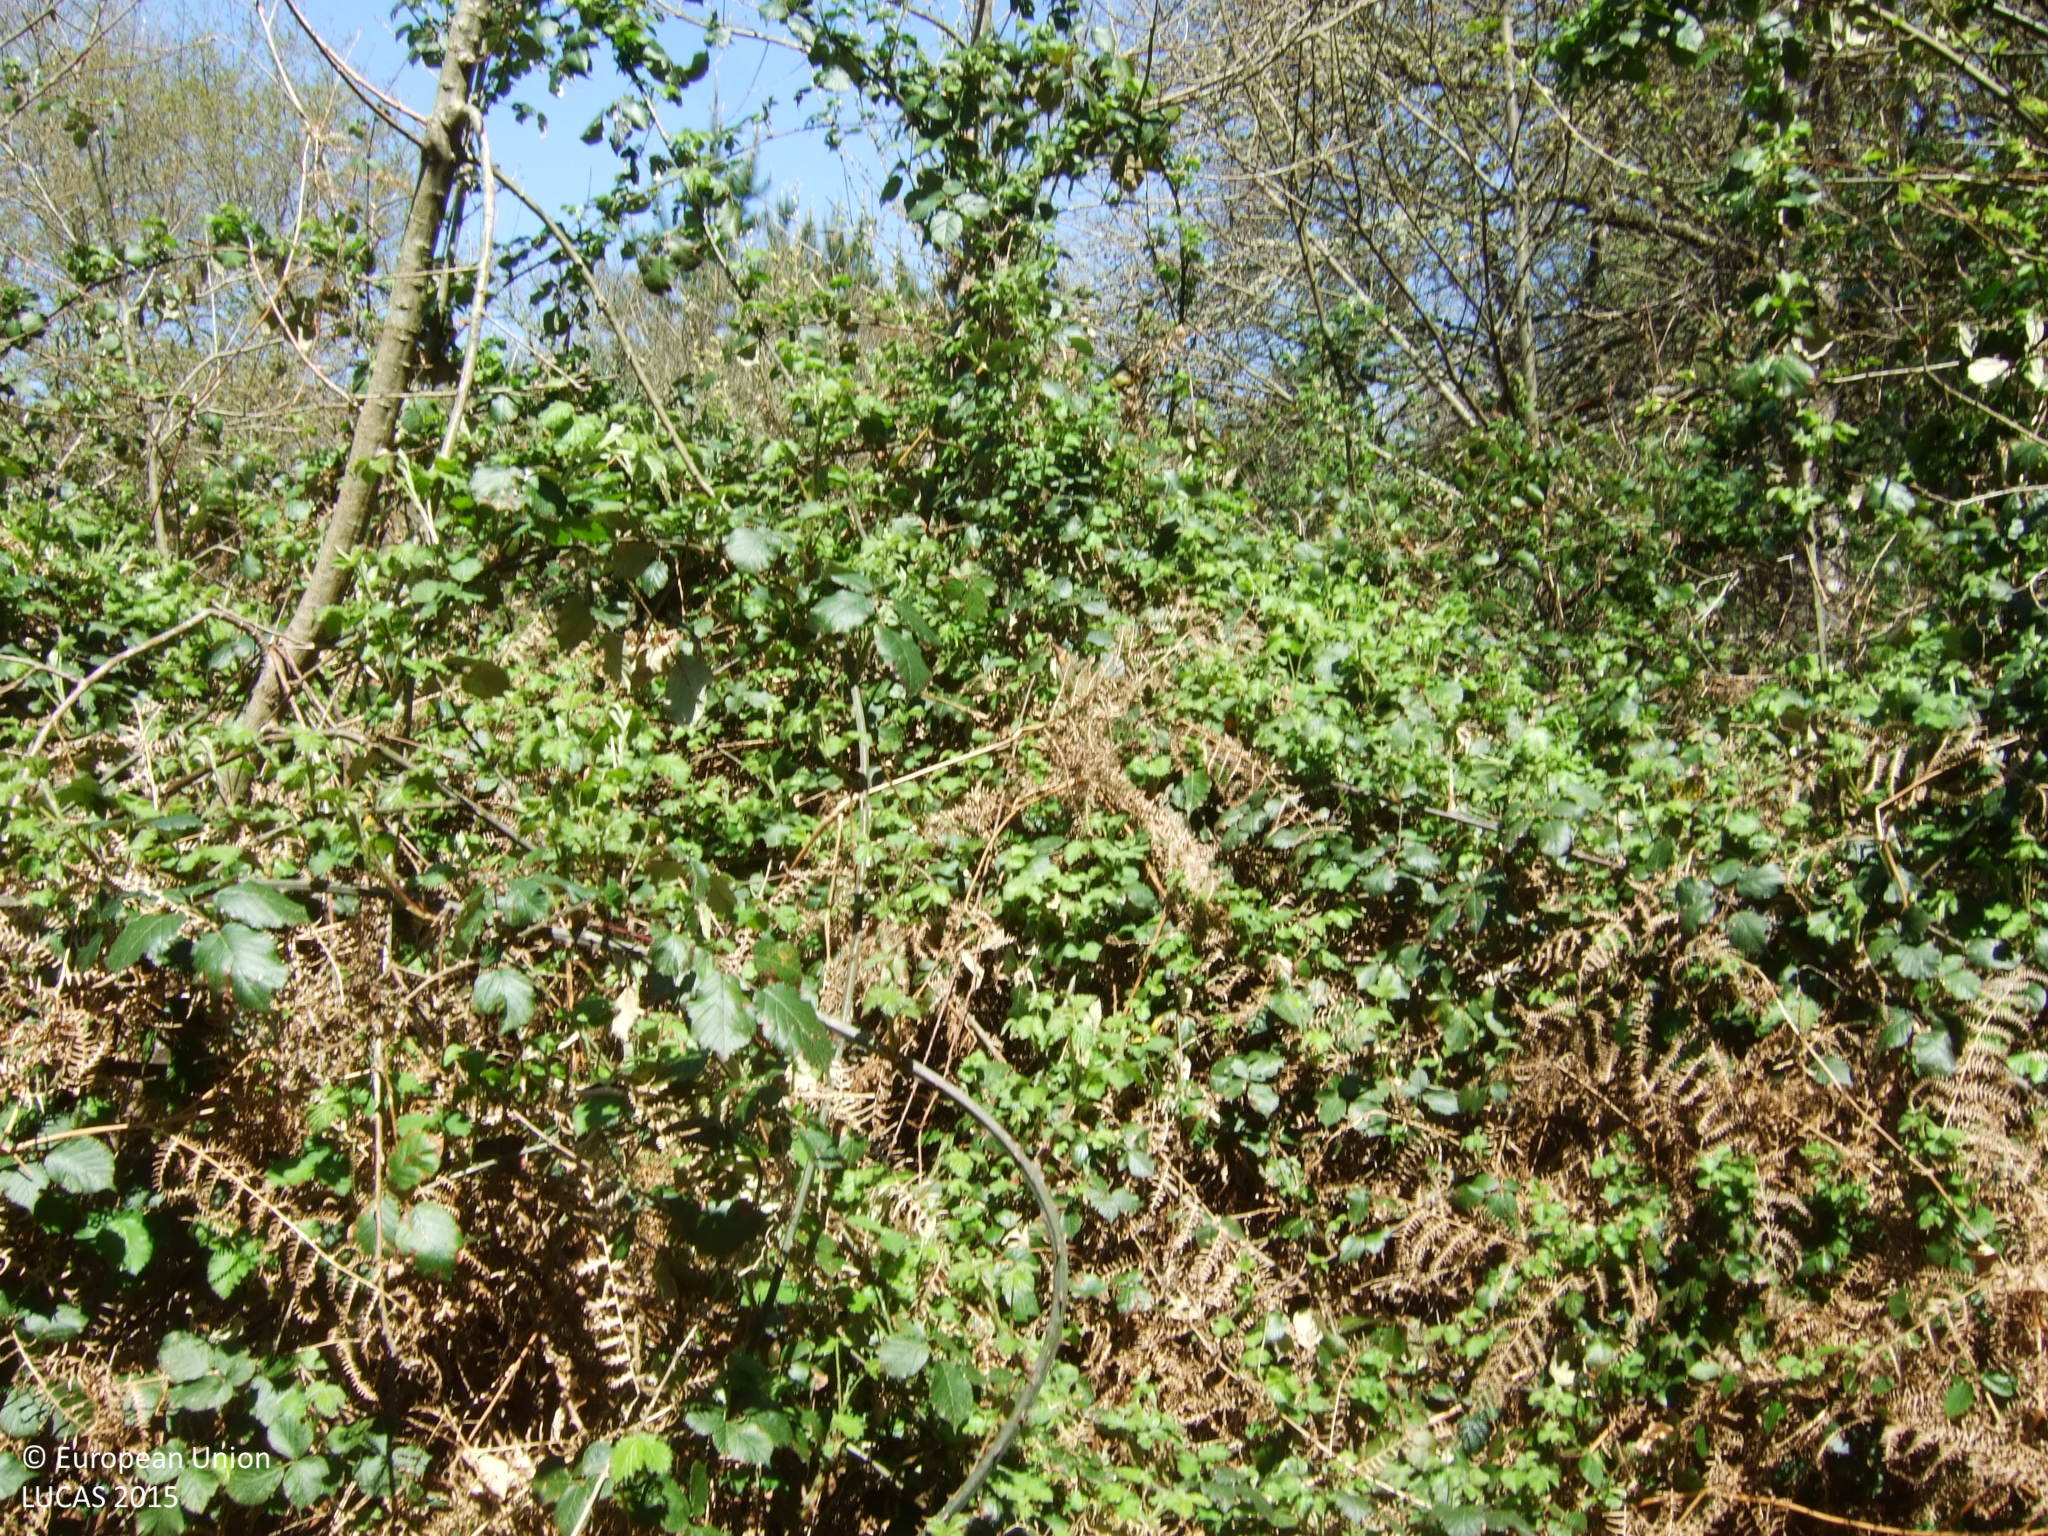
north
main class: Woodland
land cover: Broadleaved woodland
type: acidophilous oak and oak-birch forest
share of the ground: 25 - 50 %
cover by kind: broadleaved forest trees 50 %, shrubs 50 %
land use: Forestry
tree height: > 5 m
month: April
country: ES
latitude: 43.0054
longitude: -7.6598
